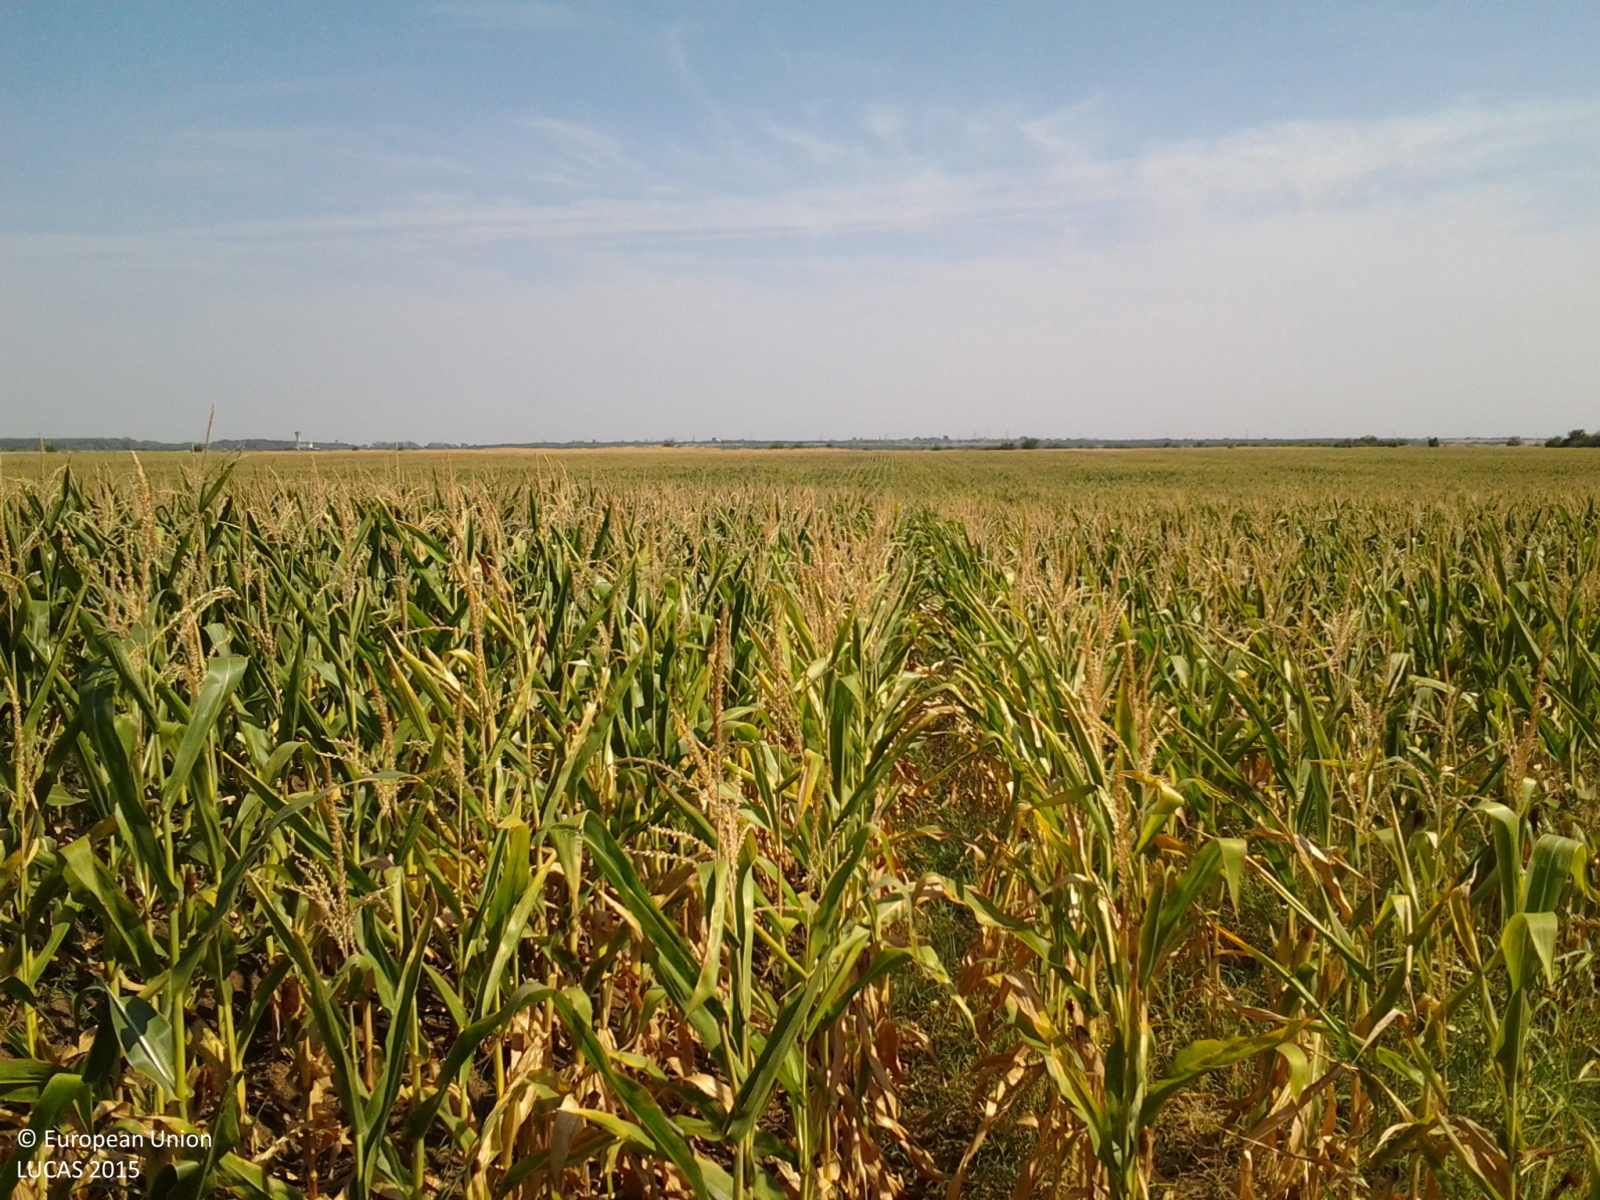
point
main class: Cropland
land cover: Maize
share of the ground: > 75 %
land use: Agriculture (excluding fallow land and kitchen gardens)
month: August
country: RO
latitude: 43.9418
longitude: 22.9095
